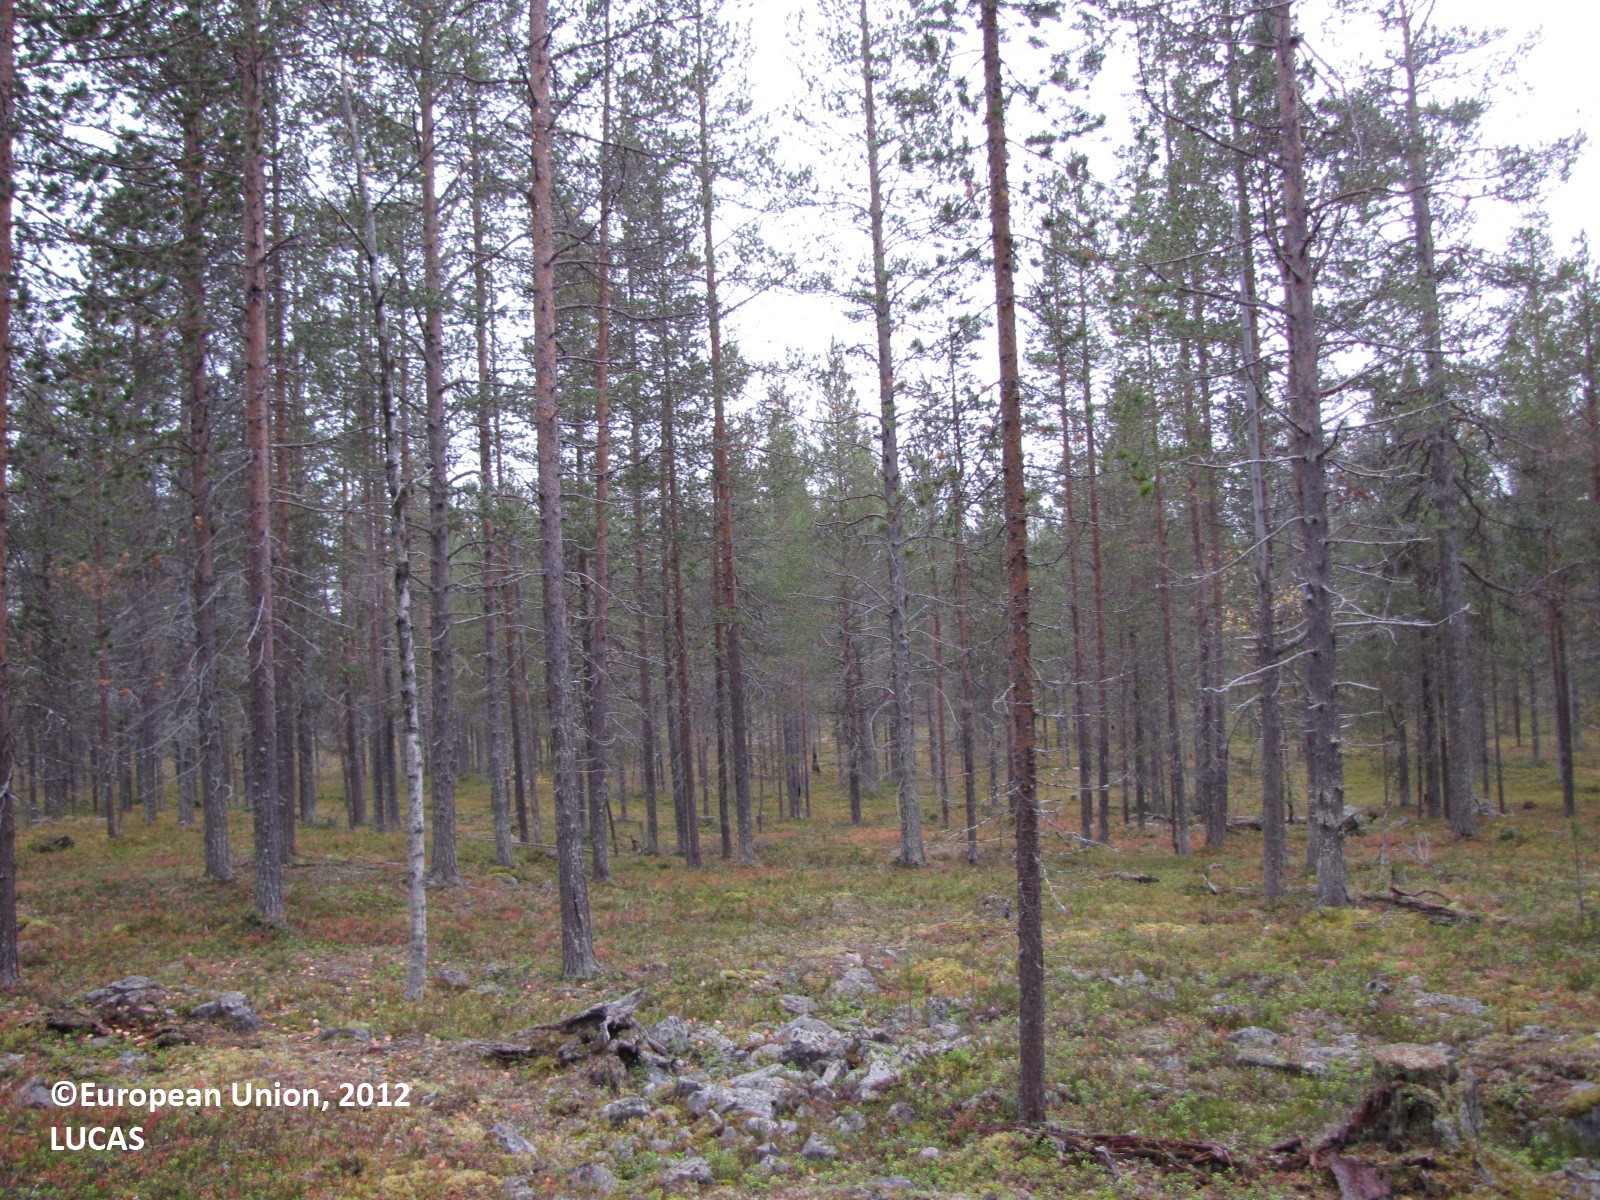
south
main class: Woodland
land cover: Pine dominated coniferous woodland
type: boreal forest
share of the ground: 25 - 50 %
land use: Forestry
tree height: > 5 m
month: September
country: FI
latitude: 67.5868
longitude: 24.0534
